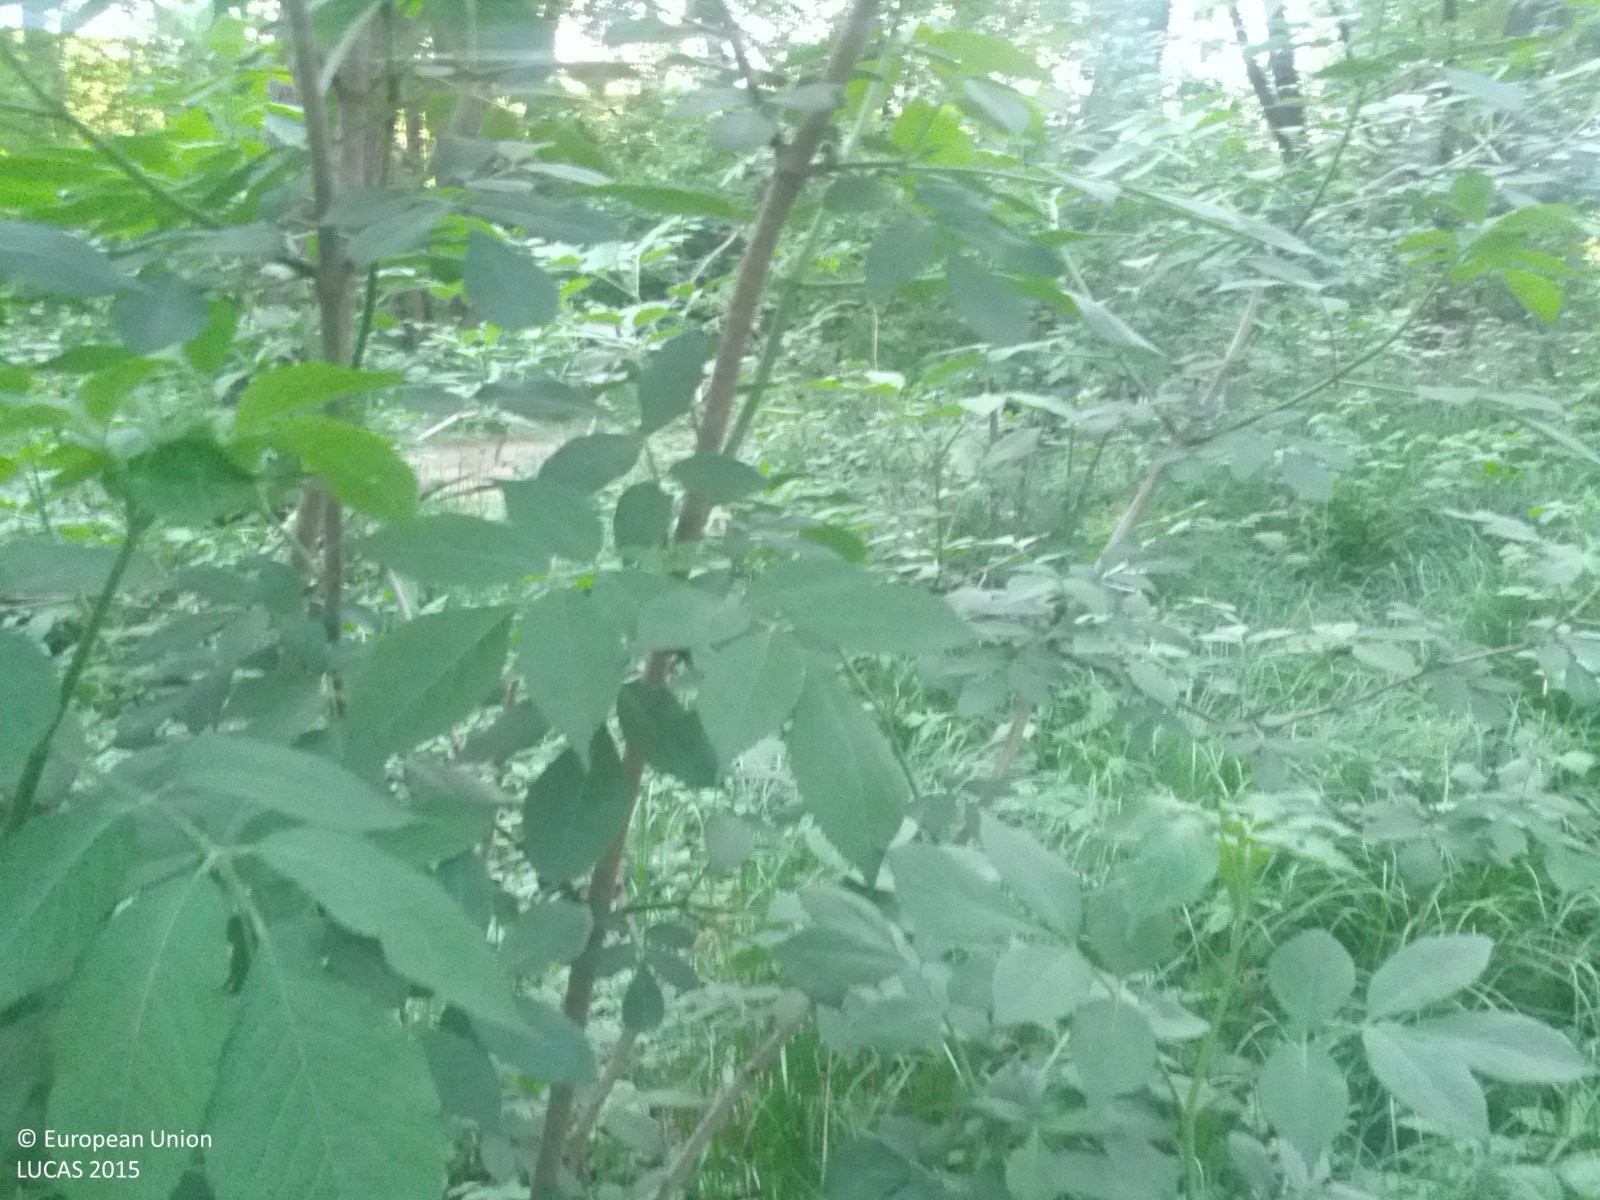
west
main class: Woodland
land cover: Broadleaved woodland
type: floodplain forest
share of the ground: > 75 %
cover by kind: broadleaved forest trees 40 %, shrubs 40 %, herbaceous plants 20 %
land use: Semi-natural and natural areas not in use
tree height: > 5 m
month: May
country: AT
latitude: 47.3325
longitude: 16.1027
